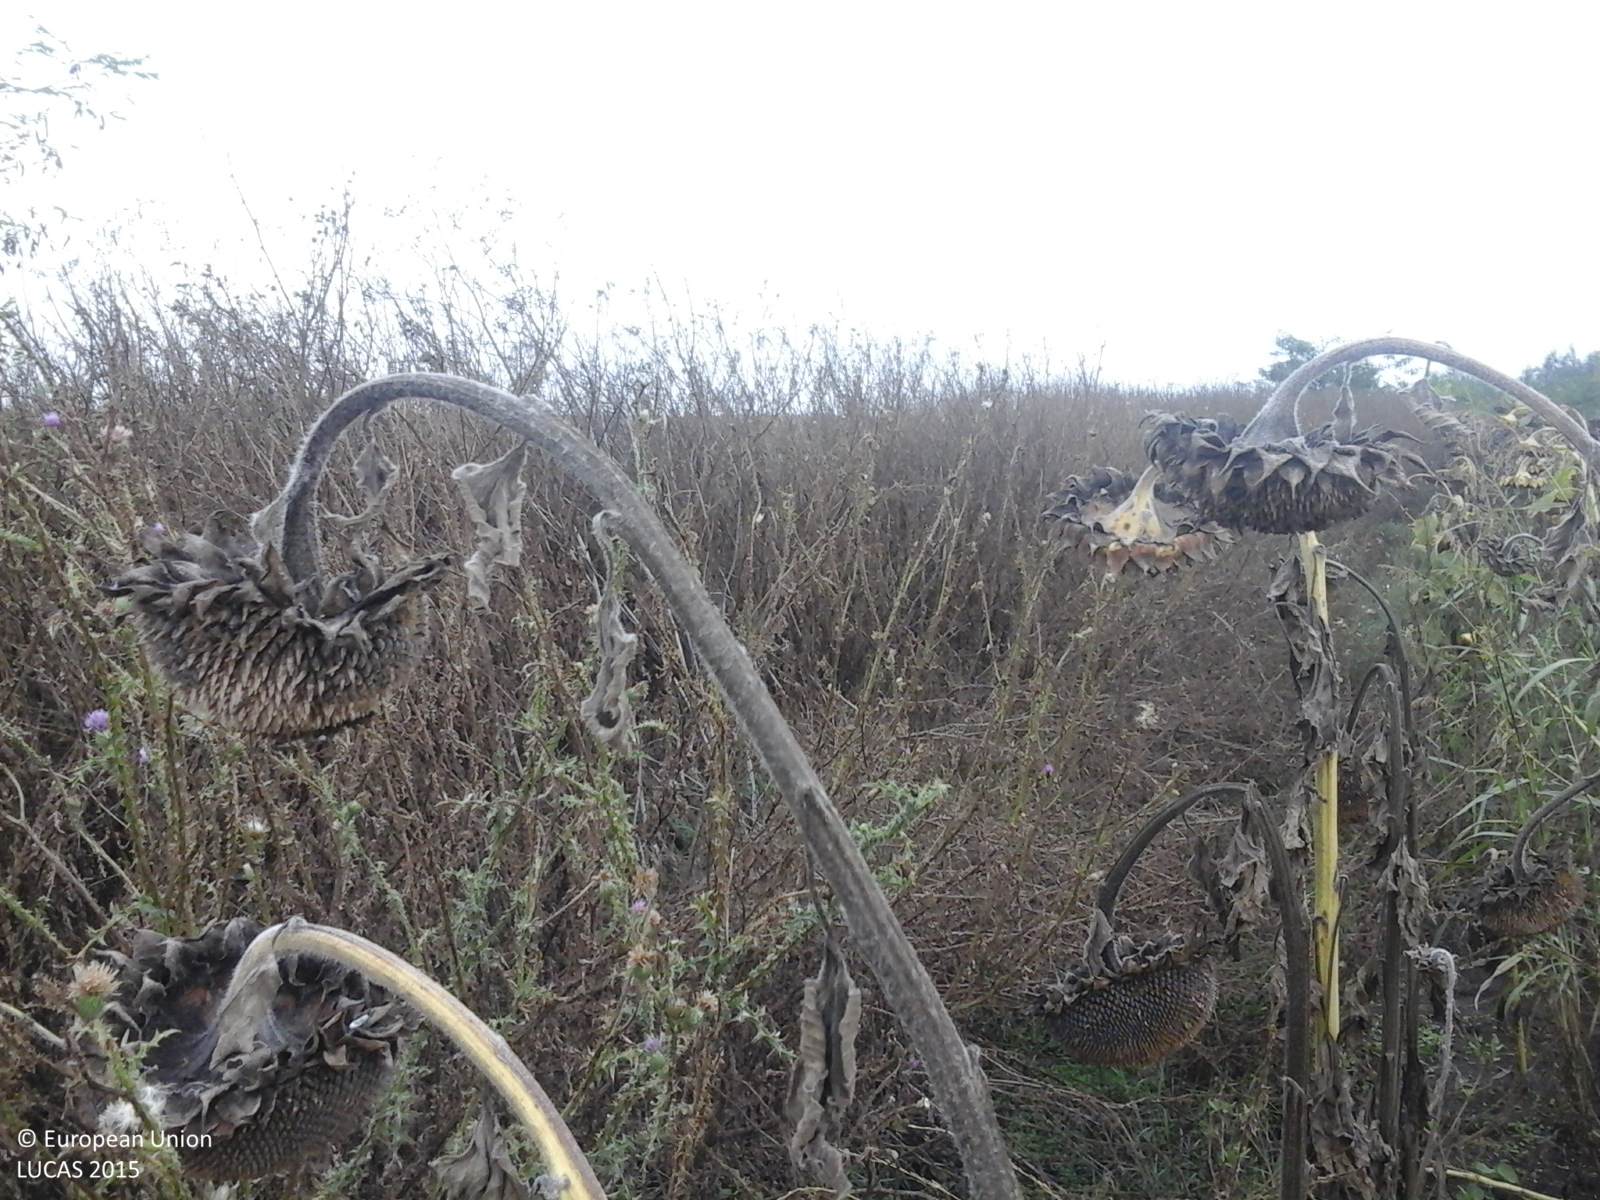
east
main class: Cropland
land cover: Sunflower
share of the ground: > 75 %
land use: Agriculture (excluding fallow land and kitchen gardens)
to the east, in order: Sunflower; Grassland with sparse tree/shrub cover; Tracks; Sugar beet
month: August
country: RO
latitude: 46.2872
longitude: 21.2087
